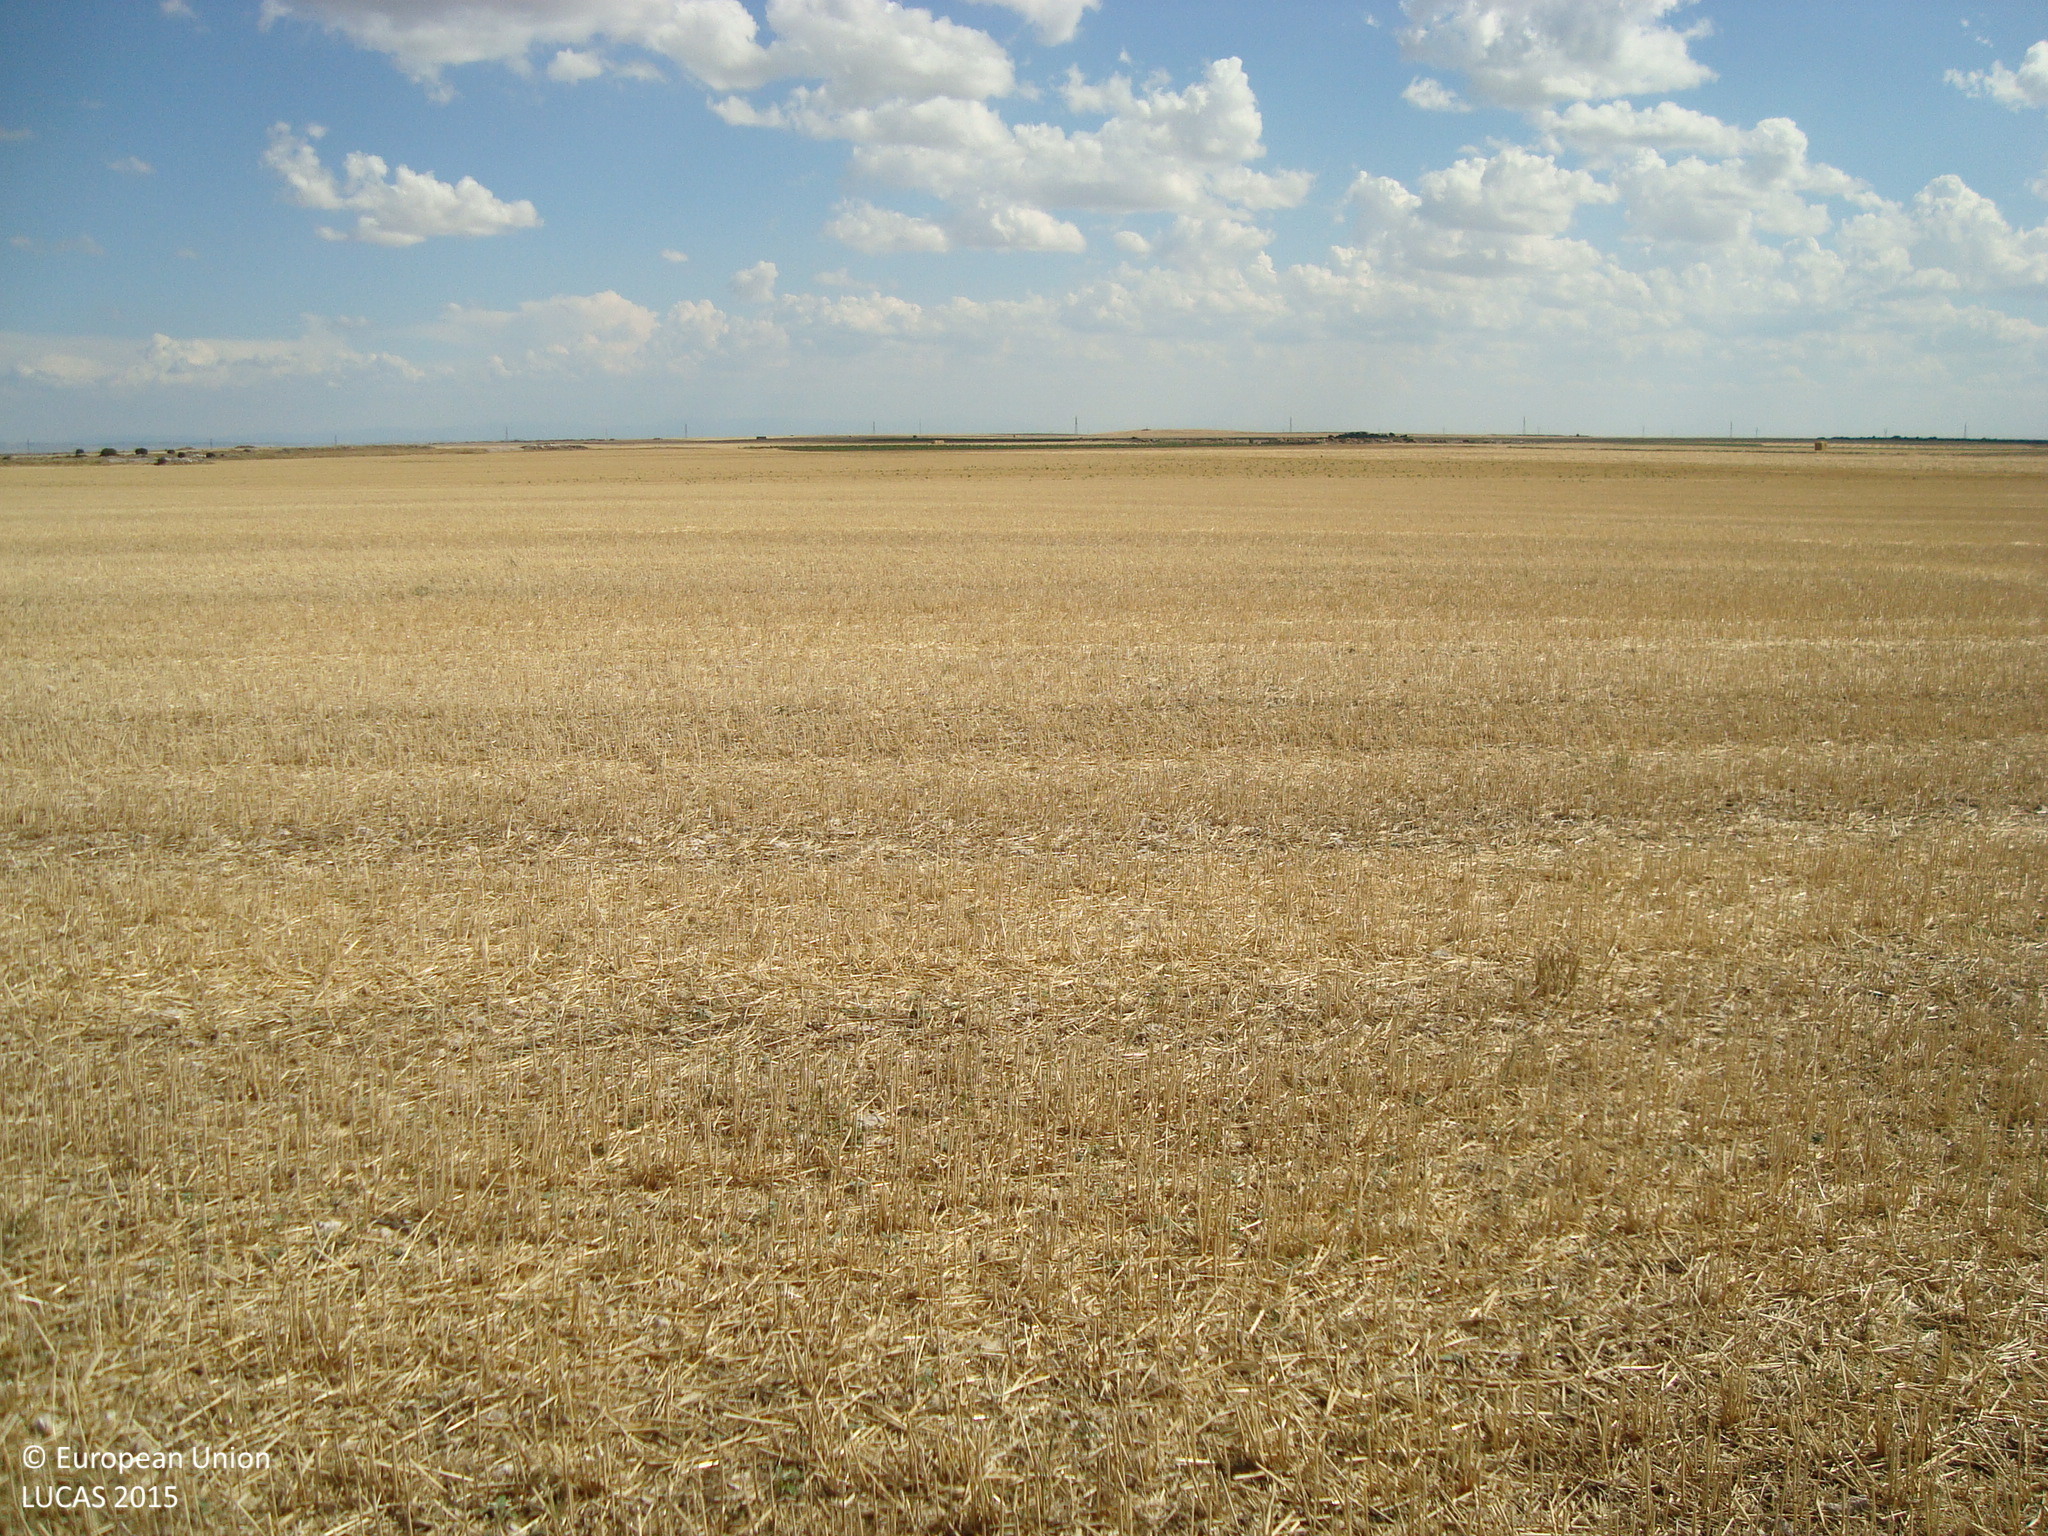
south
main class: Cropland
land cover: Barley
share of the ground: > 75 %
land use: Agriculture (excluding fallow land and kitchen gardens)
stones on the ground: < 10 %
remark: Harvested field
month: July
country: ES
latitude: 41.7189
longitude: -4.0867
